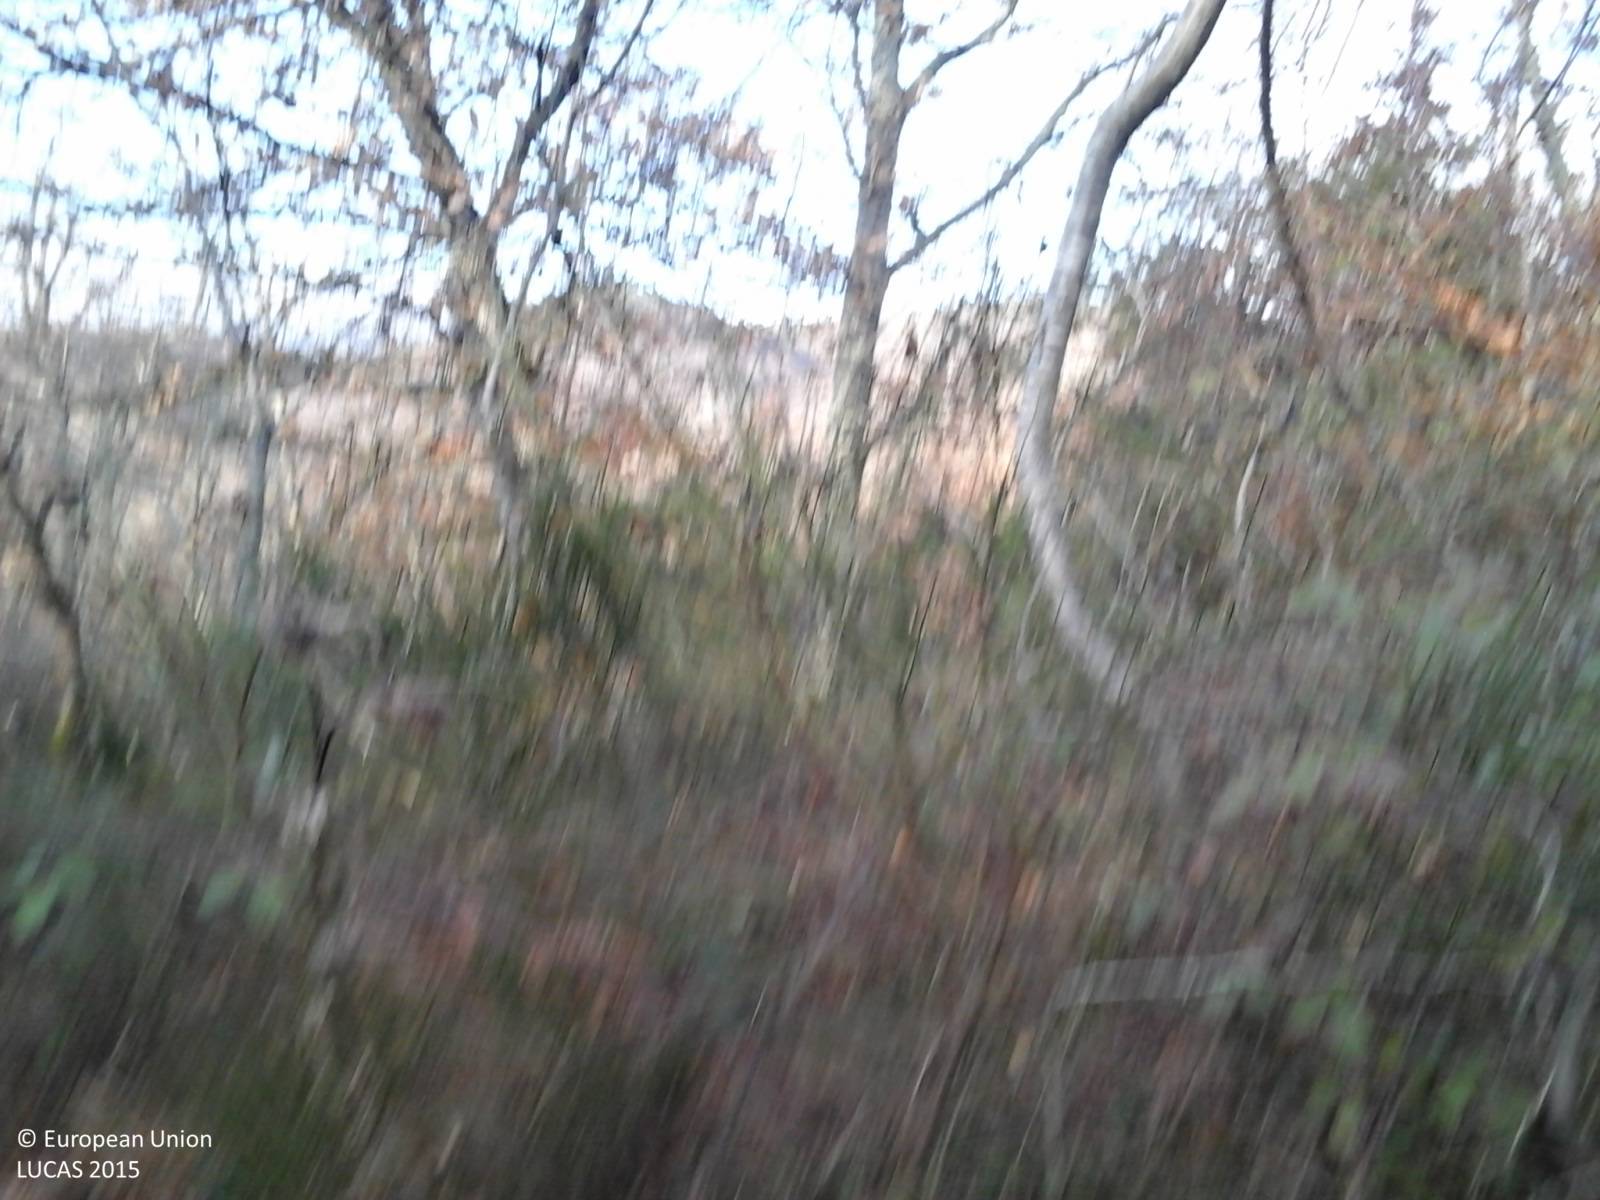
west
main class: Woodland
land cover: Broadleaved woodland
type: thermophilous deciduous forest
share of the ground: > 75 %
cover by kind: broadleaved forest trees 75 %, shrubs 15 %, coniferous forest trees 5 %, herbaceous plants 5 %
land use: Forestry
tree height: > 5 m
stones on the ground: 10 - 25 %
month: January
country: IT
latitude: 43.8314
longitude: 11.6994
